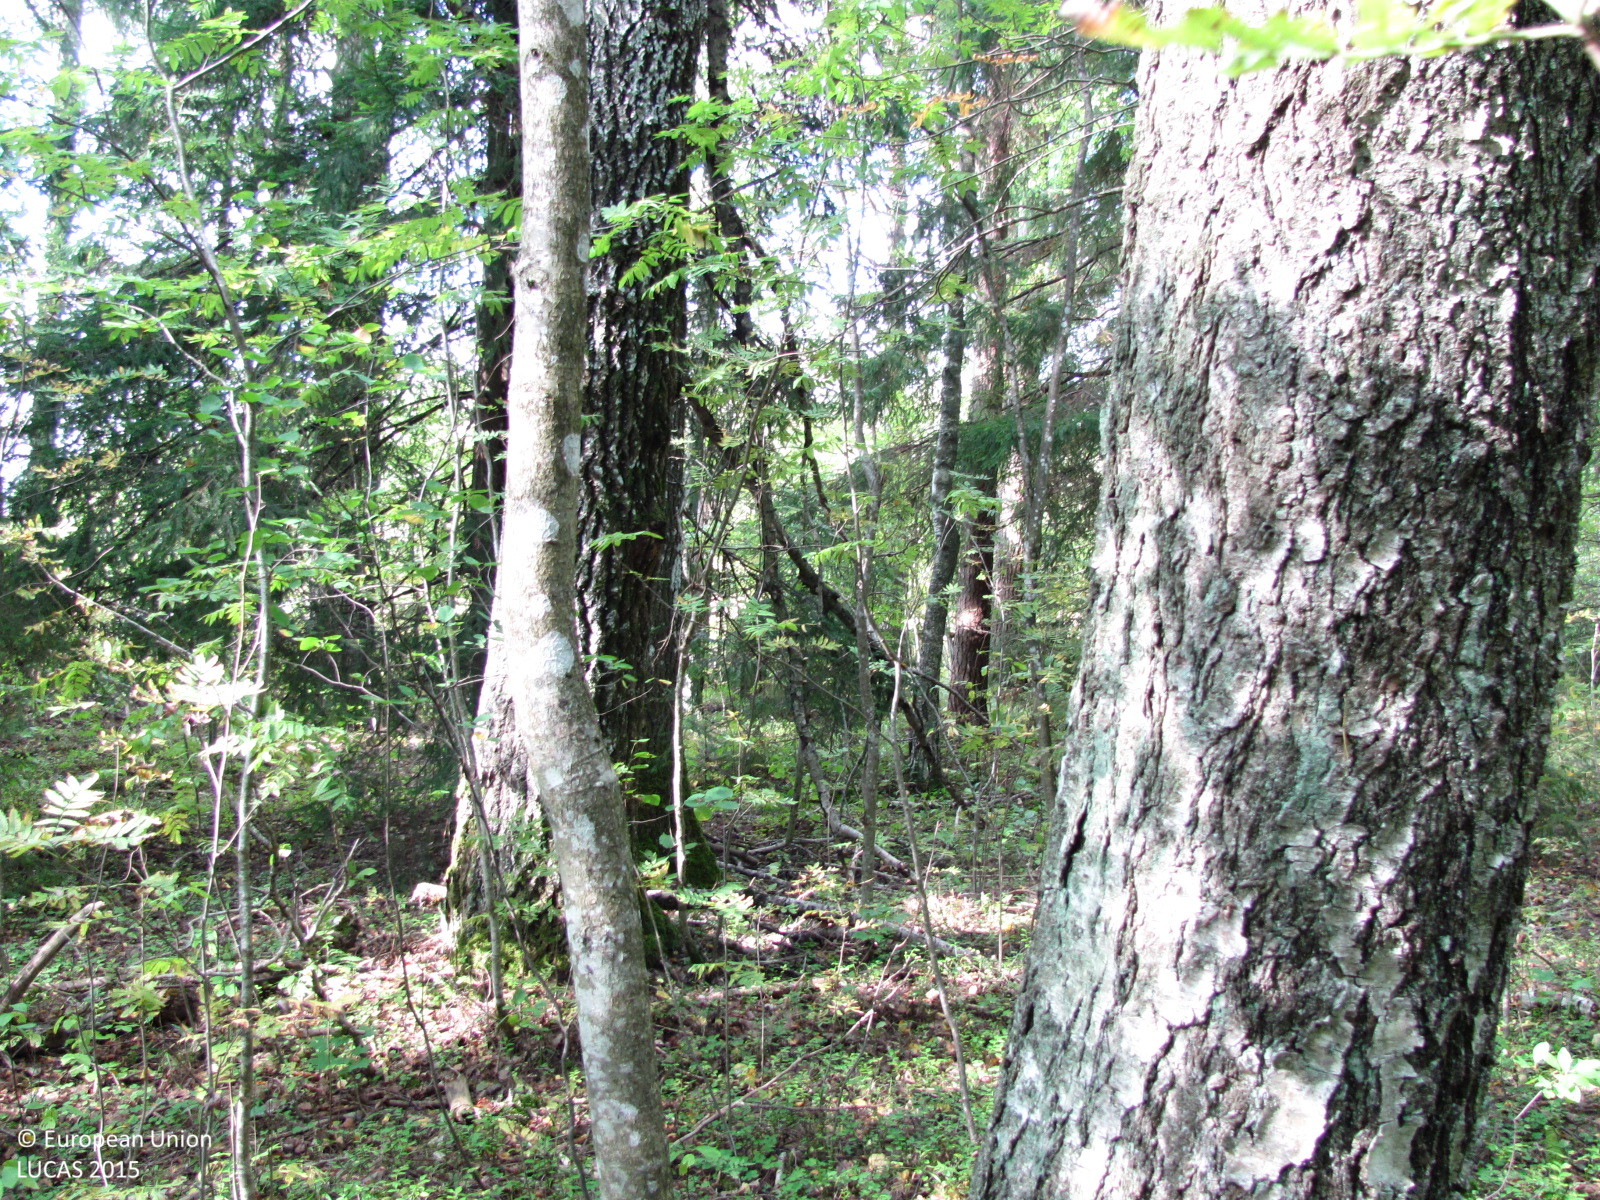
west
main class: Woodland
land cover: Other mixed woodland
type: hemiboreal forest and nemoral coniferous forest and mixed broadleaved-coniferous forest
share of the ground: > 75 %
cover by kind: coniferous forest trees 40 %, broadleaved forest trees 40 %, herbaceous plants 10 %, lichens and mosses 10 %
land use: Forestry
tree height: > 5 m
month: September
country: LV
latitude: 56.6615
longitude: 25.1027
